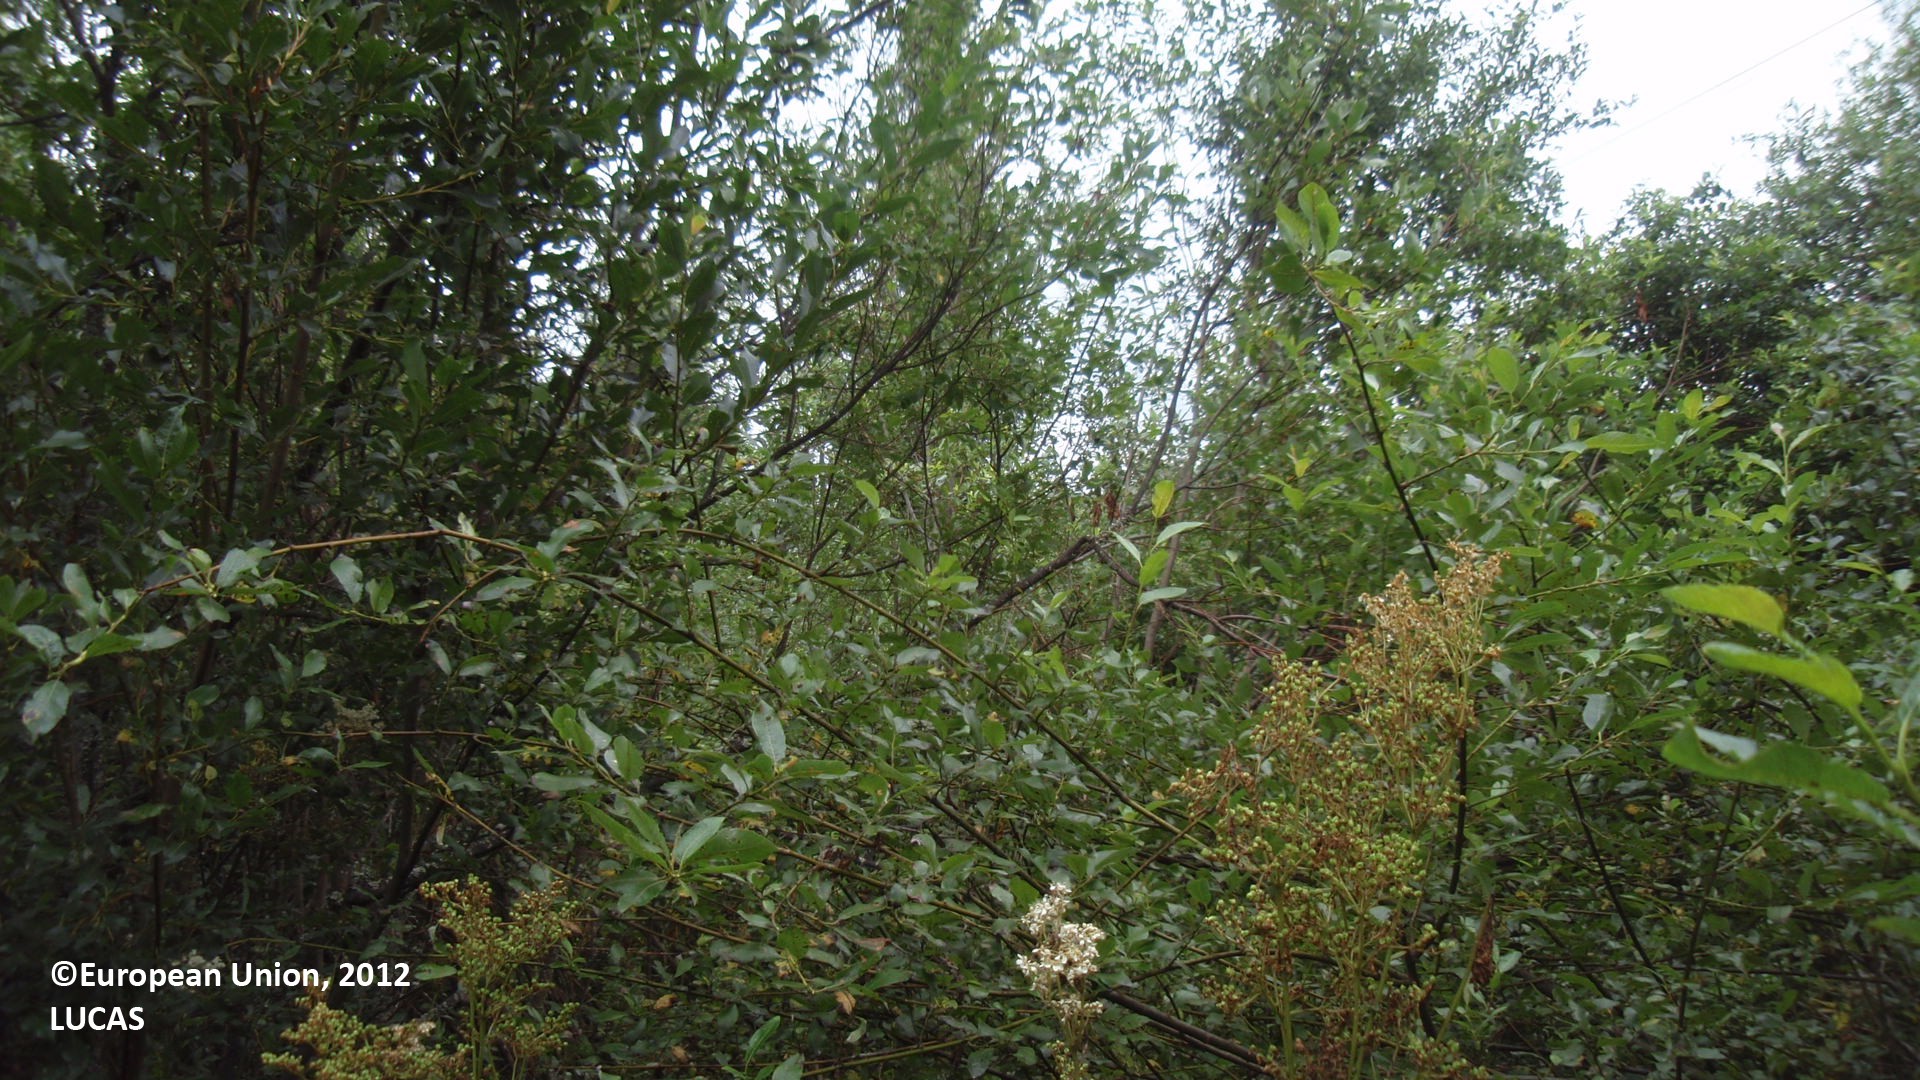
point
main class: Shrubland
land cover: Shrubland with sparse tree cover
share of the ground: > 75 %
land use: Abandoned areas
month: August
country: FI
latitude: 61.2540
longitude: 27.6889
